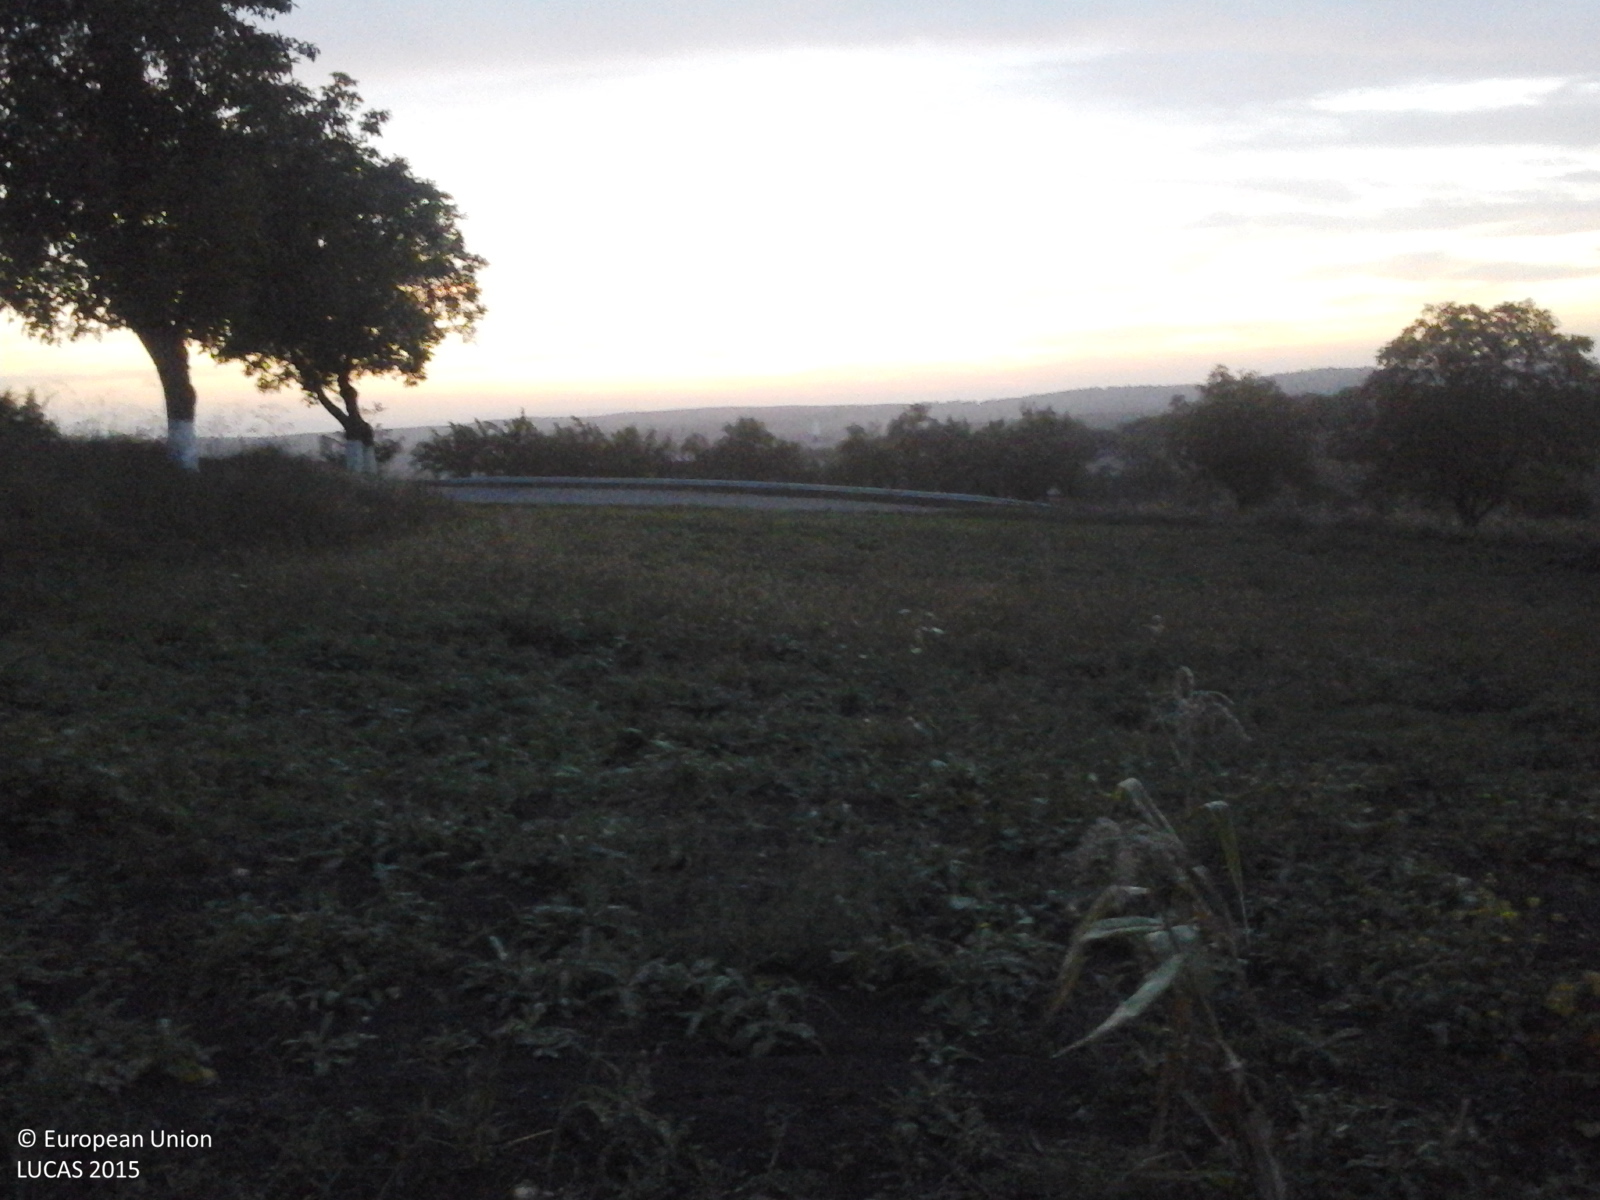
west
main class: Cropland
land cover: Lucerne
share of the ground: > 75 %
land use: Agriculture (excluding fallow land and kitchen gardens)
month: September
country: RO
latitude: 46.5969
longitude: 23.9790
